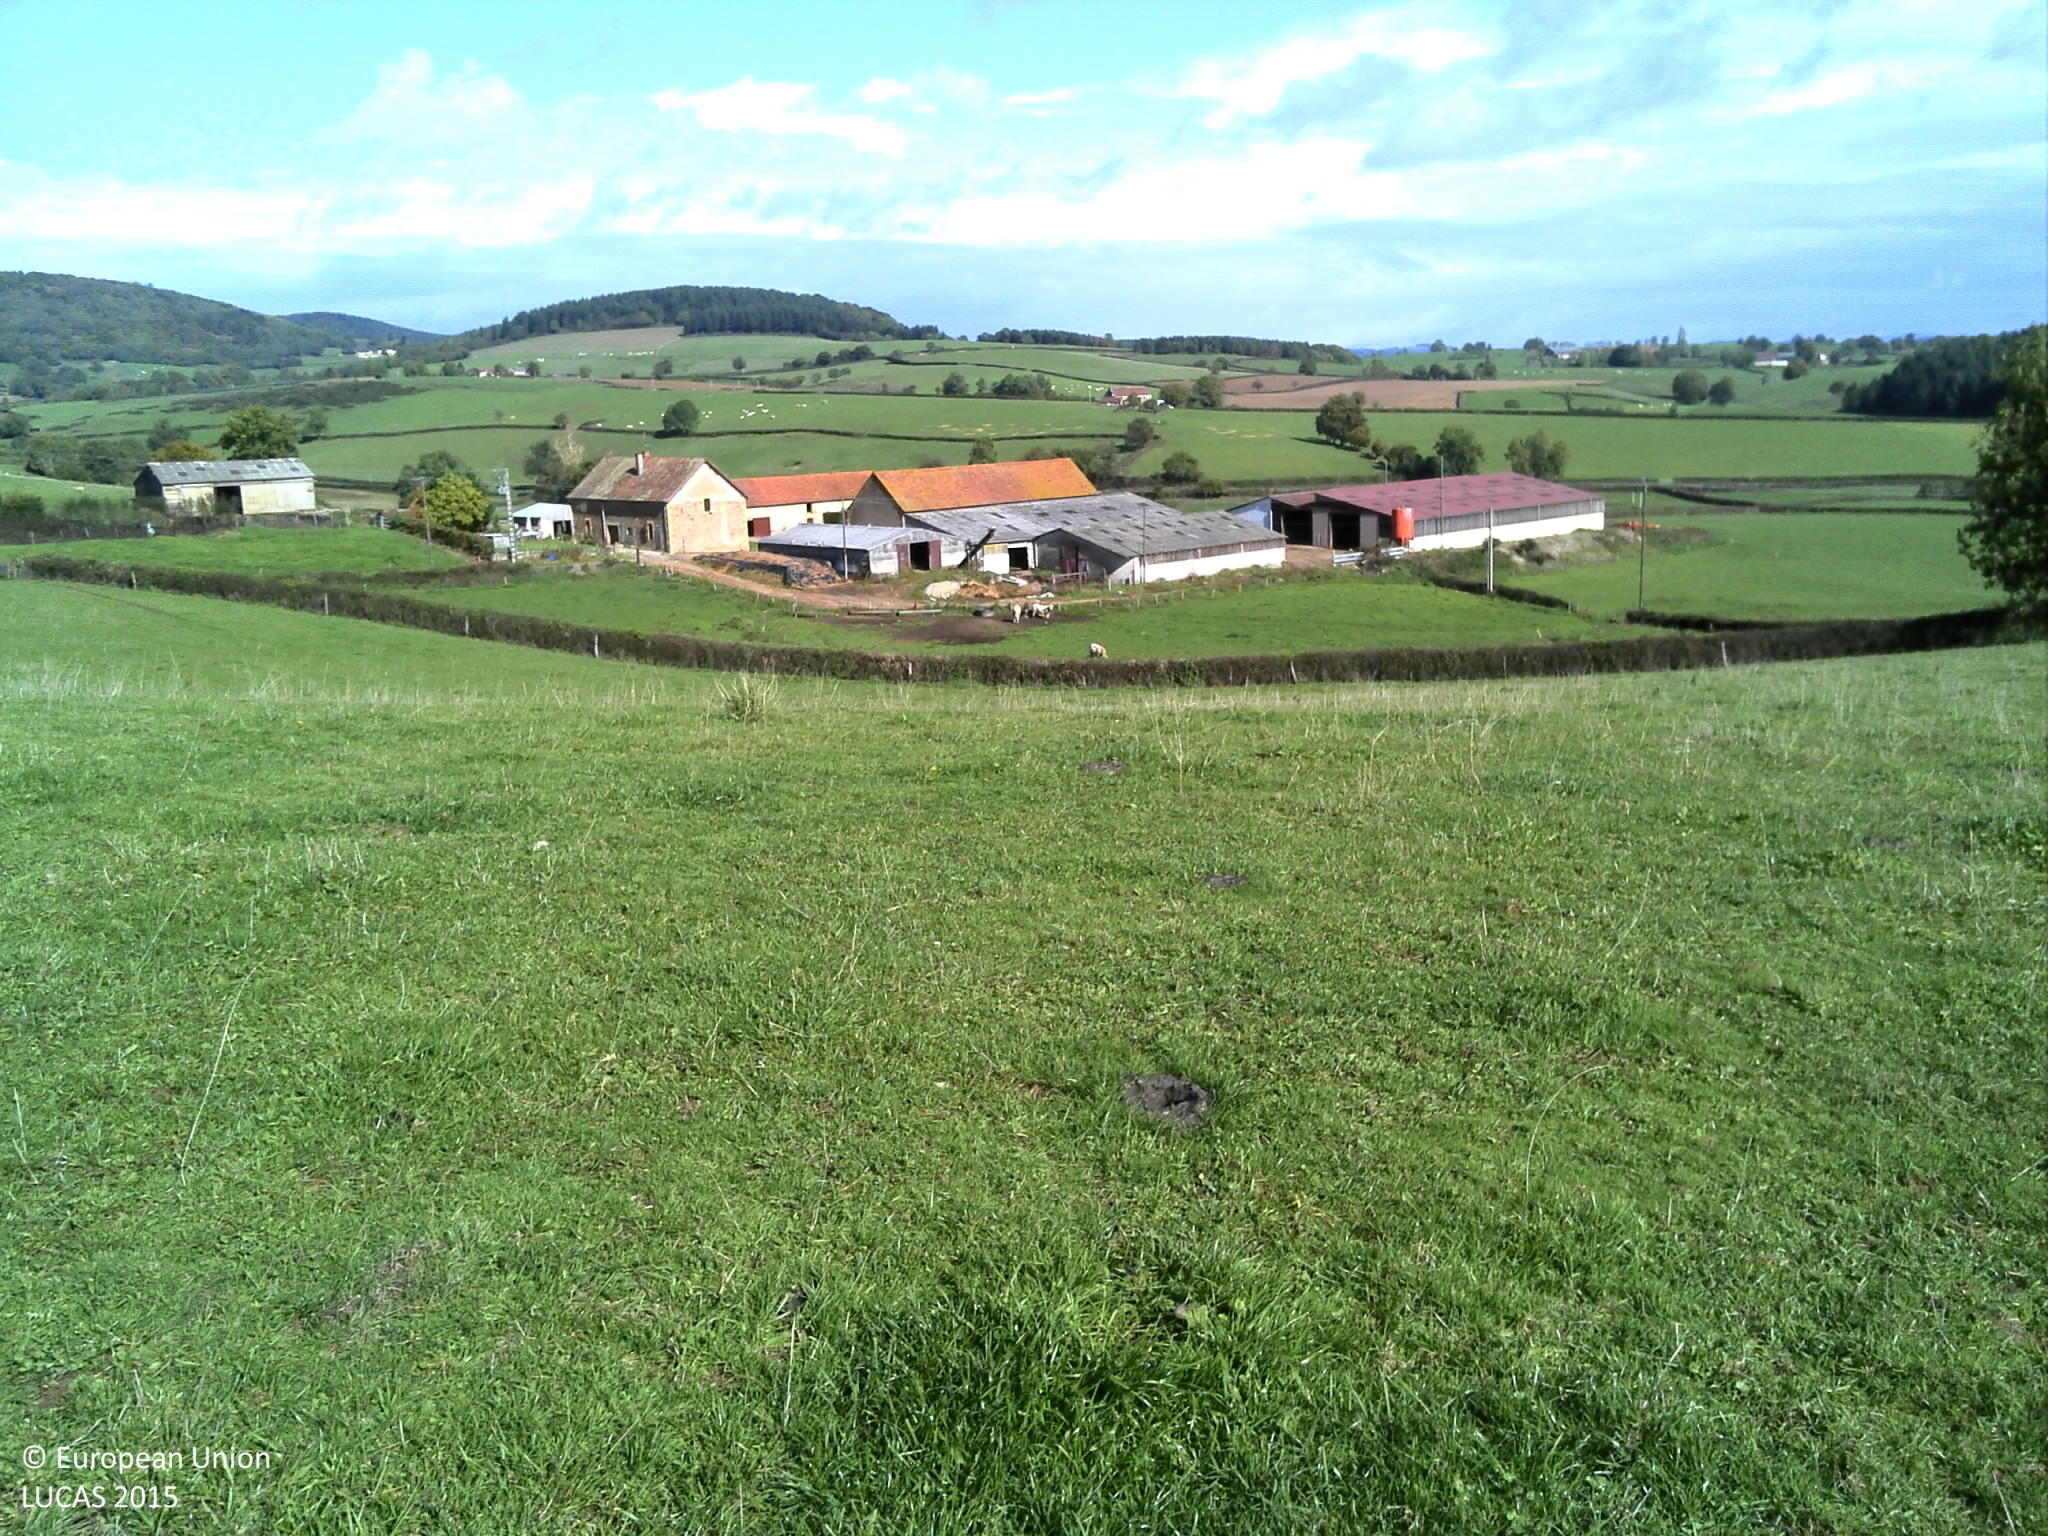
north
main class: Grassland
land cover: Grassland without tree/shrub cover
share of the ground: > 75 %
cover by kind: herbaceous plants 100 %
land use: Agriculture (excluding fallow land and kitchen gardens)
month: October
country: FR
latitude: 46.6553
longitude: 4.0543
